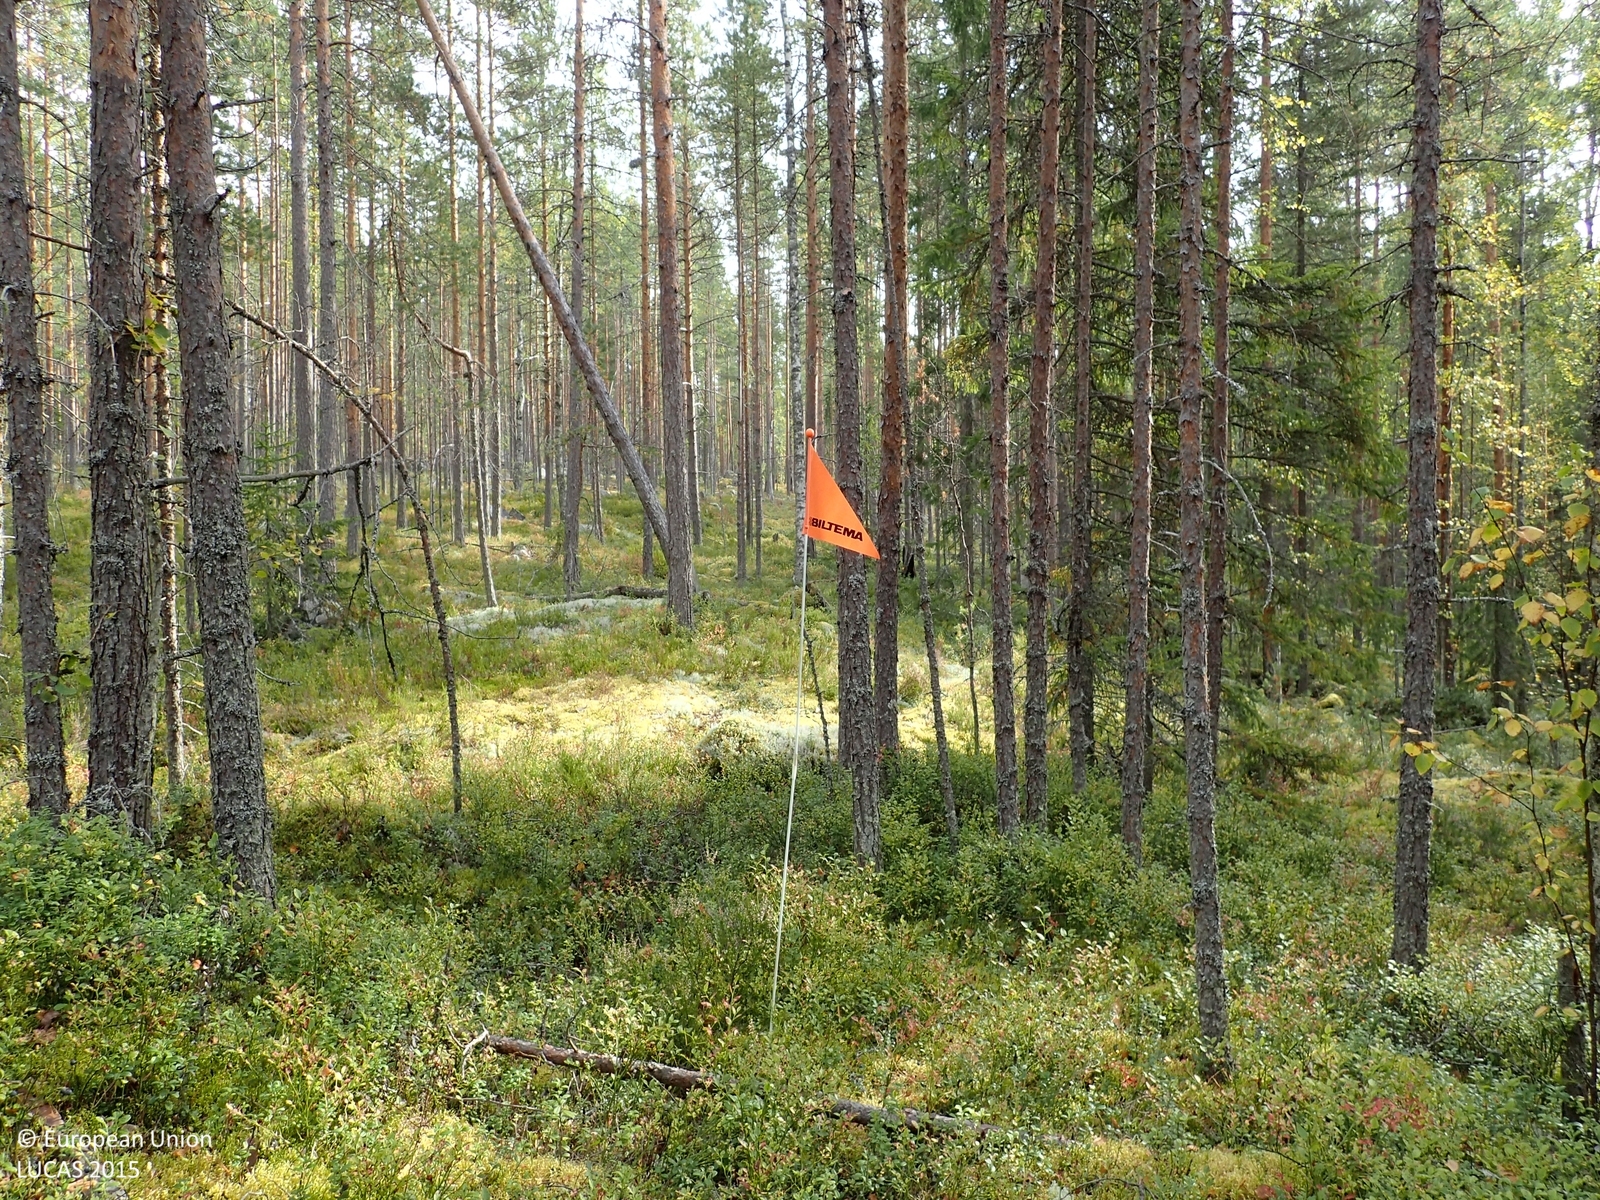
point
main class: Woodland
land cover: Pine dominated coniferous woodland
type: boreal forest
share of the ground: 50 - 75 %
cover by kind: coniferous forest trees 70 %, shrubs 25 %, lichens and mosses 5 %
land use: Forestry
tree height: > 5 m
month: September
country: FI
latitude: 63.0693
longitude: 25.1993
